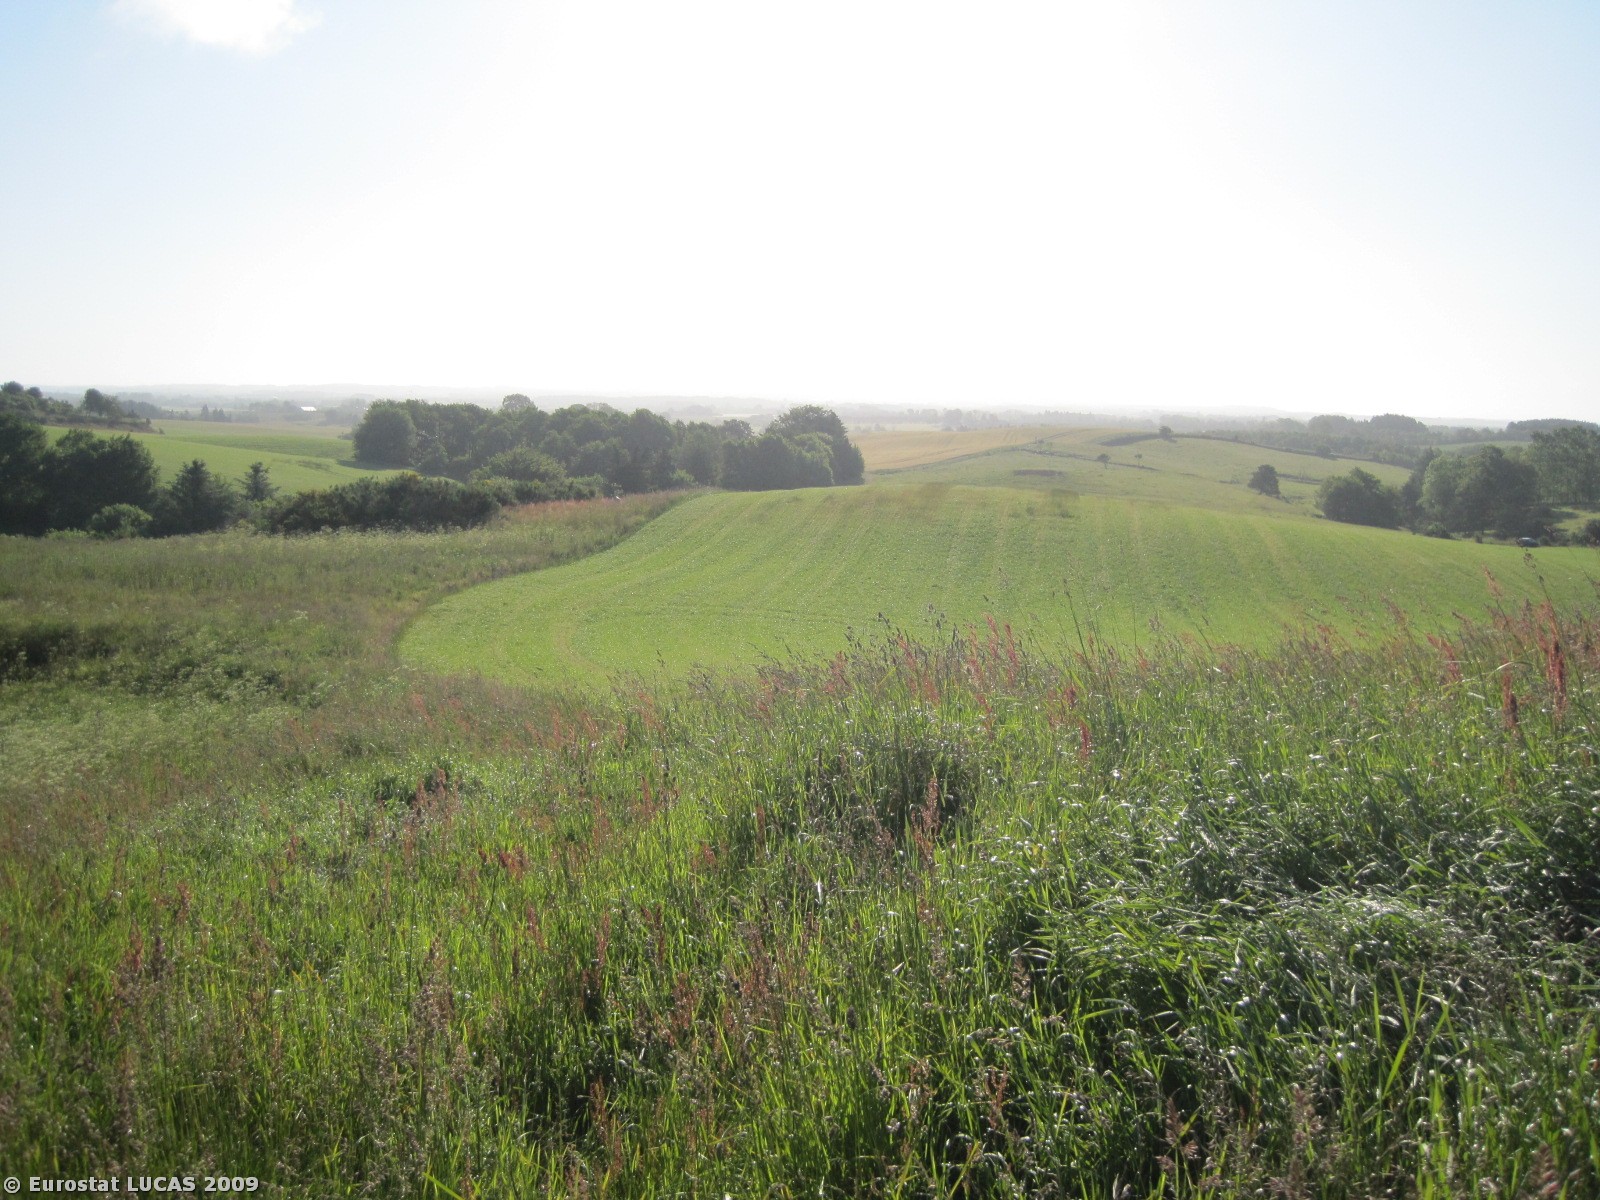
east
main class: Grassland
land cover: Grassland without tree/shrub cover
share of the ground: > 75 %
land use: Unused
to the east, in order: Grassland without tree/shrub cover; Tracks; Grassland without tree/shrub cover; Fences; Grassland without tree/shrub cover
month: June
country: DK
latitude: 57.2302
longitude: 10.2481
